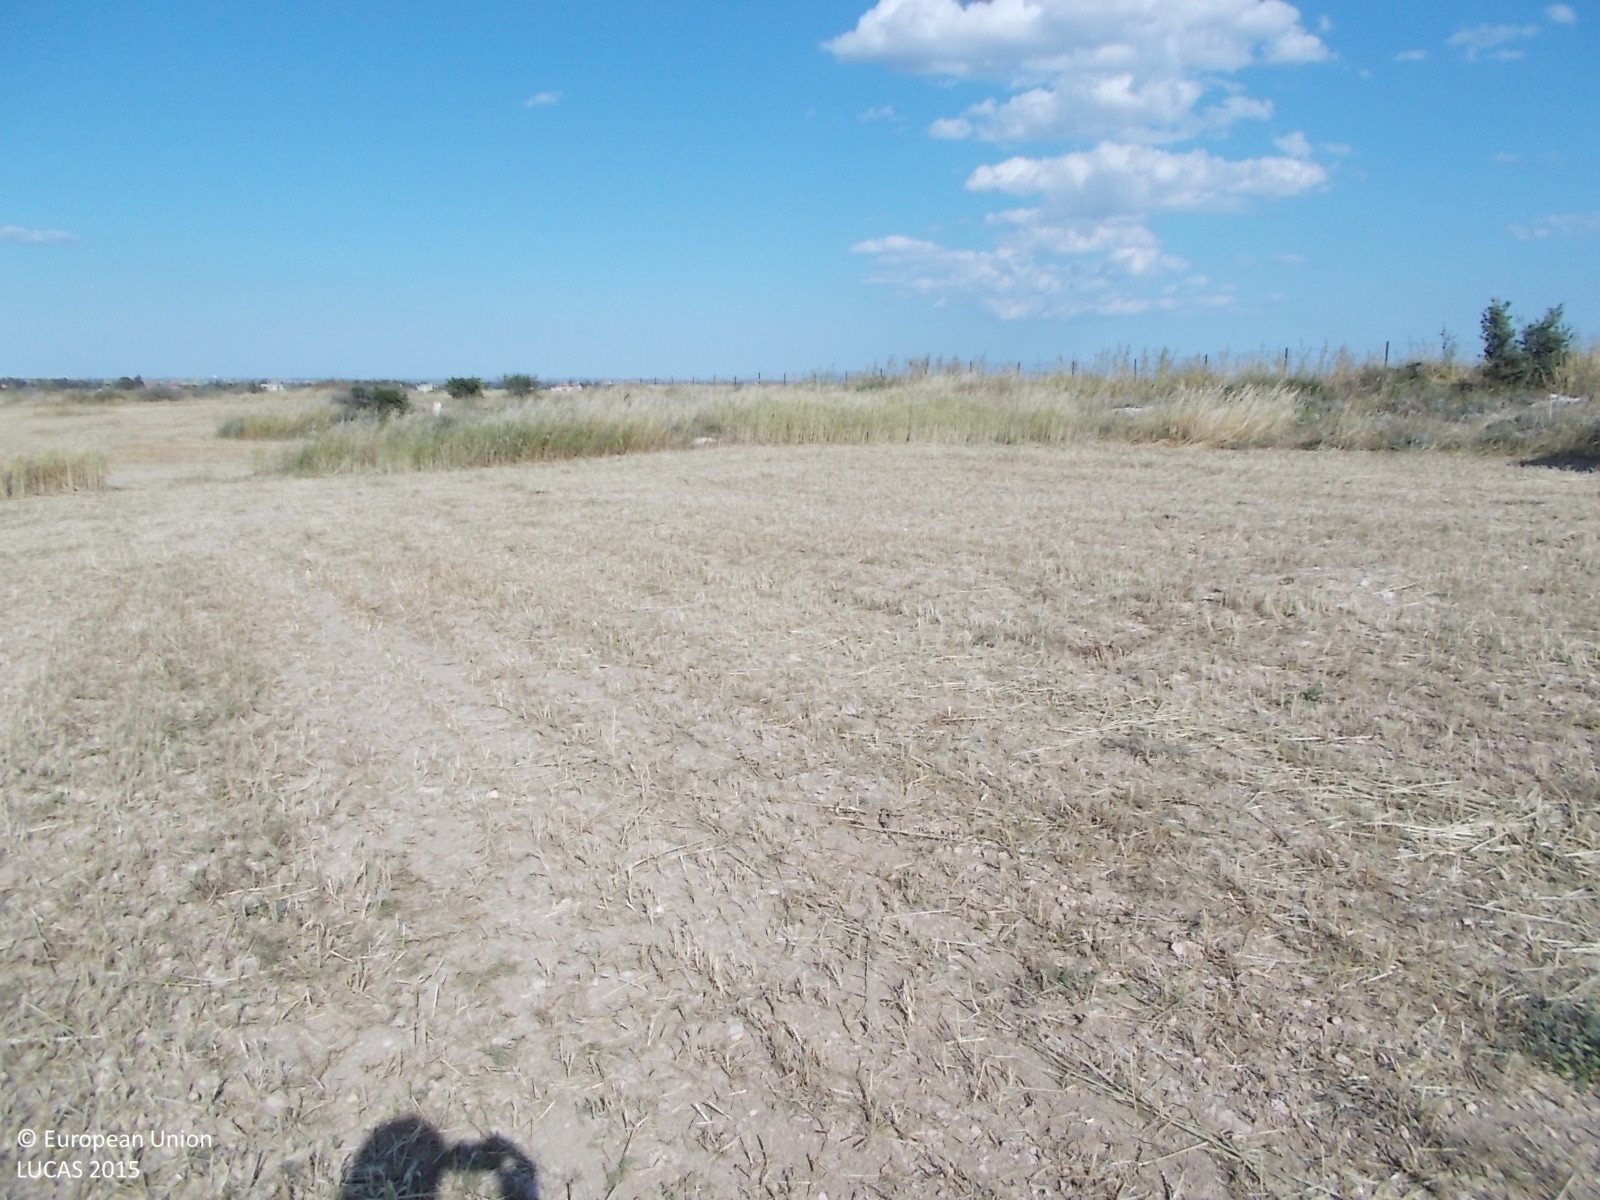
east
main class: Cropland
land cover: Common wheat
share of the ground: < 10 %
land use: Agriculture (excluding fallow land and kitchen gardens)
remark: Harvested field
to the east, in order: Common wheat; Shrubland without tree cover; Rock outcrops; Shrubland without tree cover; Fences; Grass margins; Tracks; Grass margins; Fences; Grassland without tree/shrub cover; Grassland with sparse tree/shrub cover
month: April
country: CY
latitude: 35.0276
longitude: 33.6911
